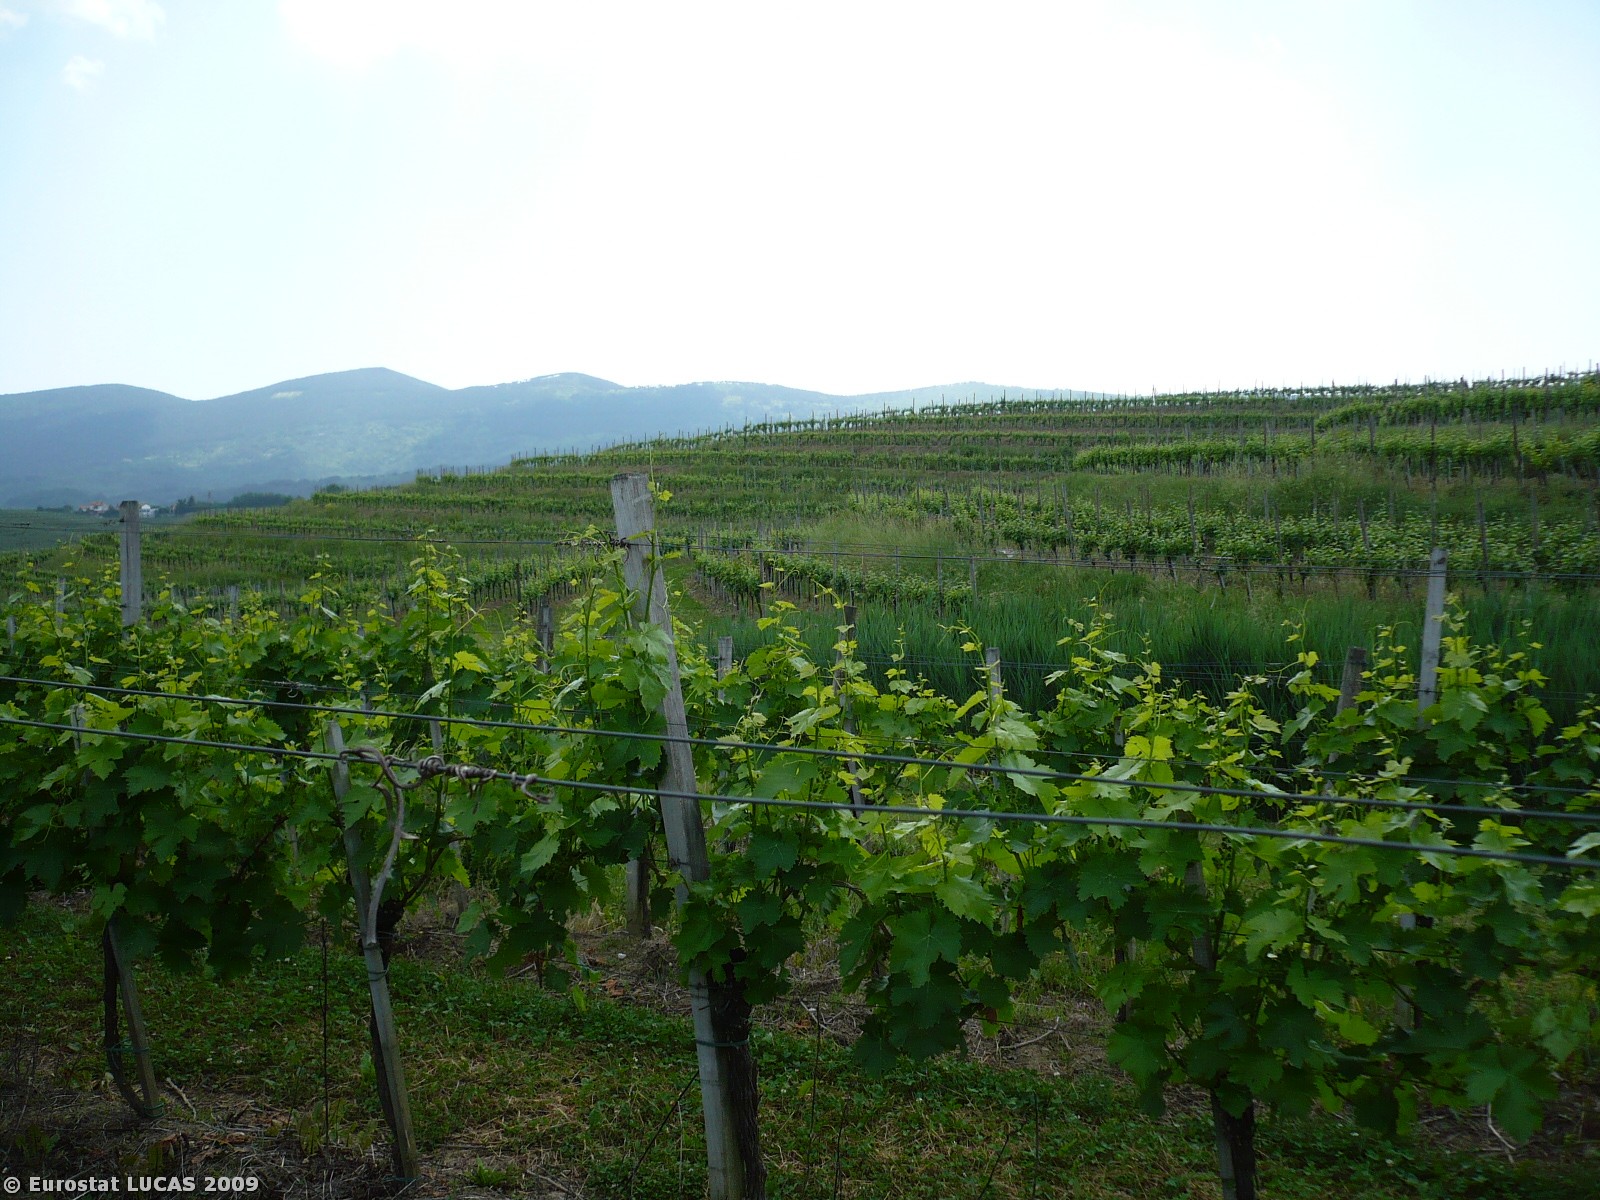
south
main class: Cropland
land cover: Vineyards
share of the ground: > 75 %
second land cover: Grassland with sparse tree/shrub cover
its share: > 75 %
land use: Agriculture (excluding fallow land and kitchen gardens)
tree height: < 5 m
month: May
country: SI
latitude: 45.9105
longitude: 13.6444
